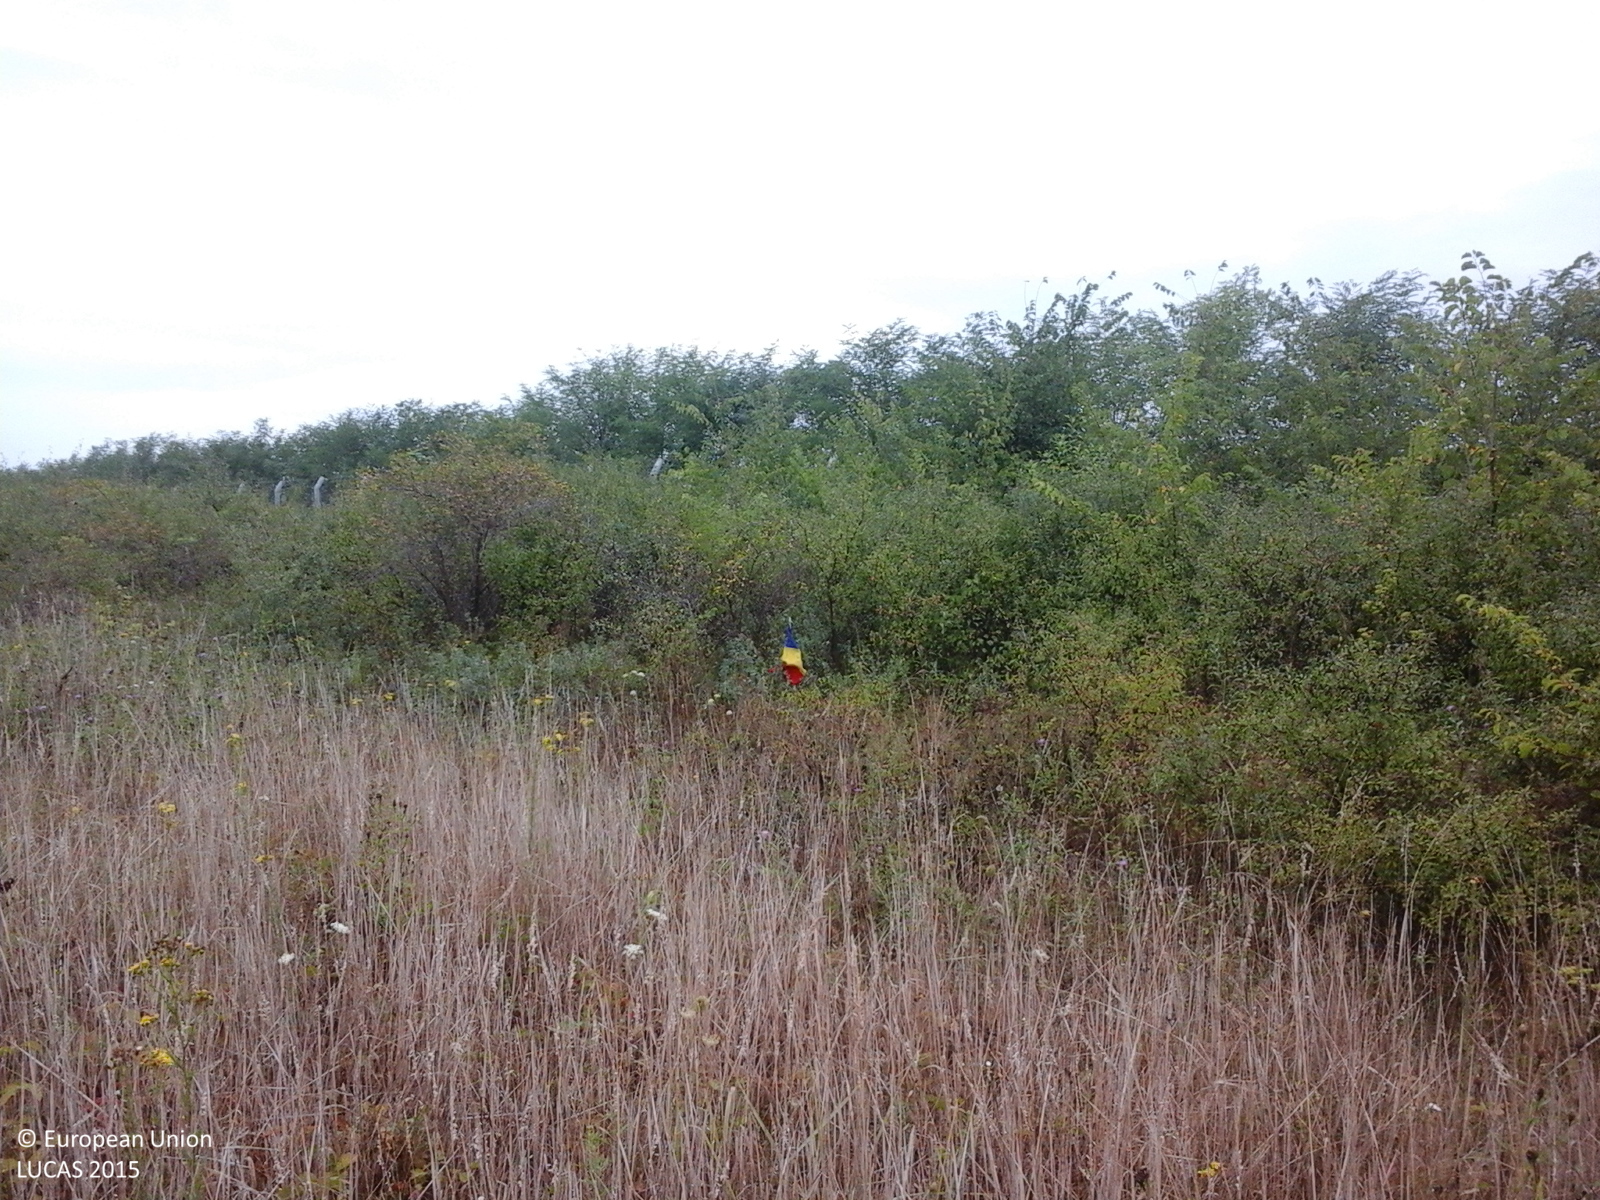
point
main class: Shrubland
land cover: Shrubland with sparse tree cover
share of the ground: > 75 %
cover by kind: shrubs 90 %, broadleaved forest trees 5 %, herbaceous plants 5 %
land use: Semi-natural and natural areas not in use
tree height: < 5 m
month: August
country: RO
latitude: 45.7914
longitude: 21.7564
